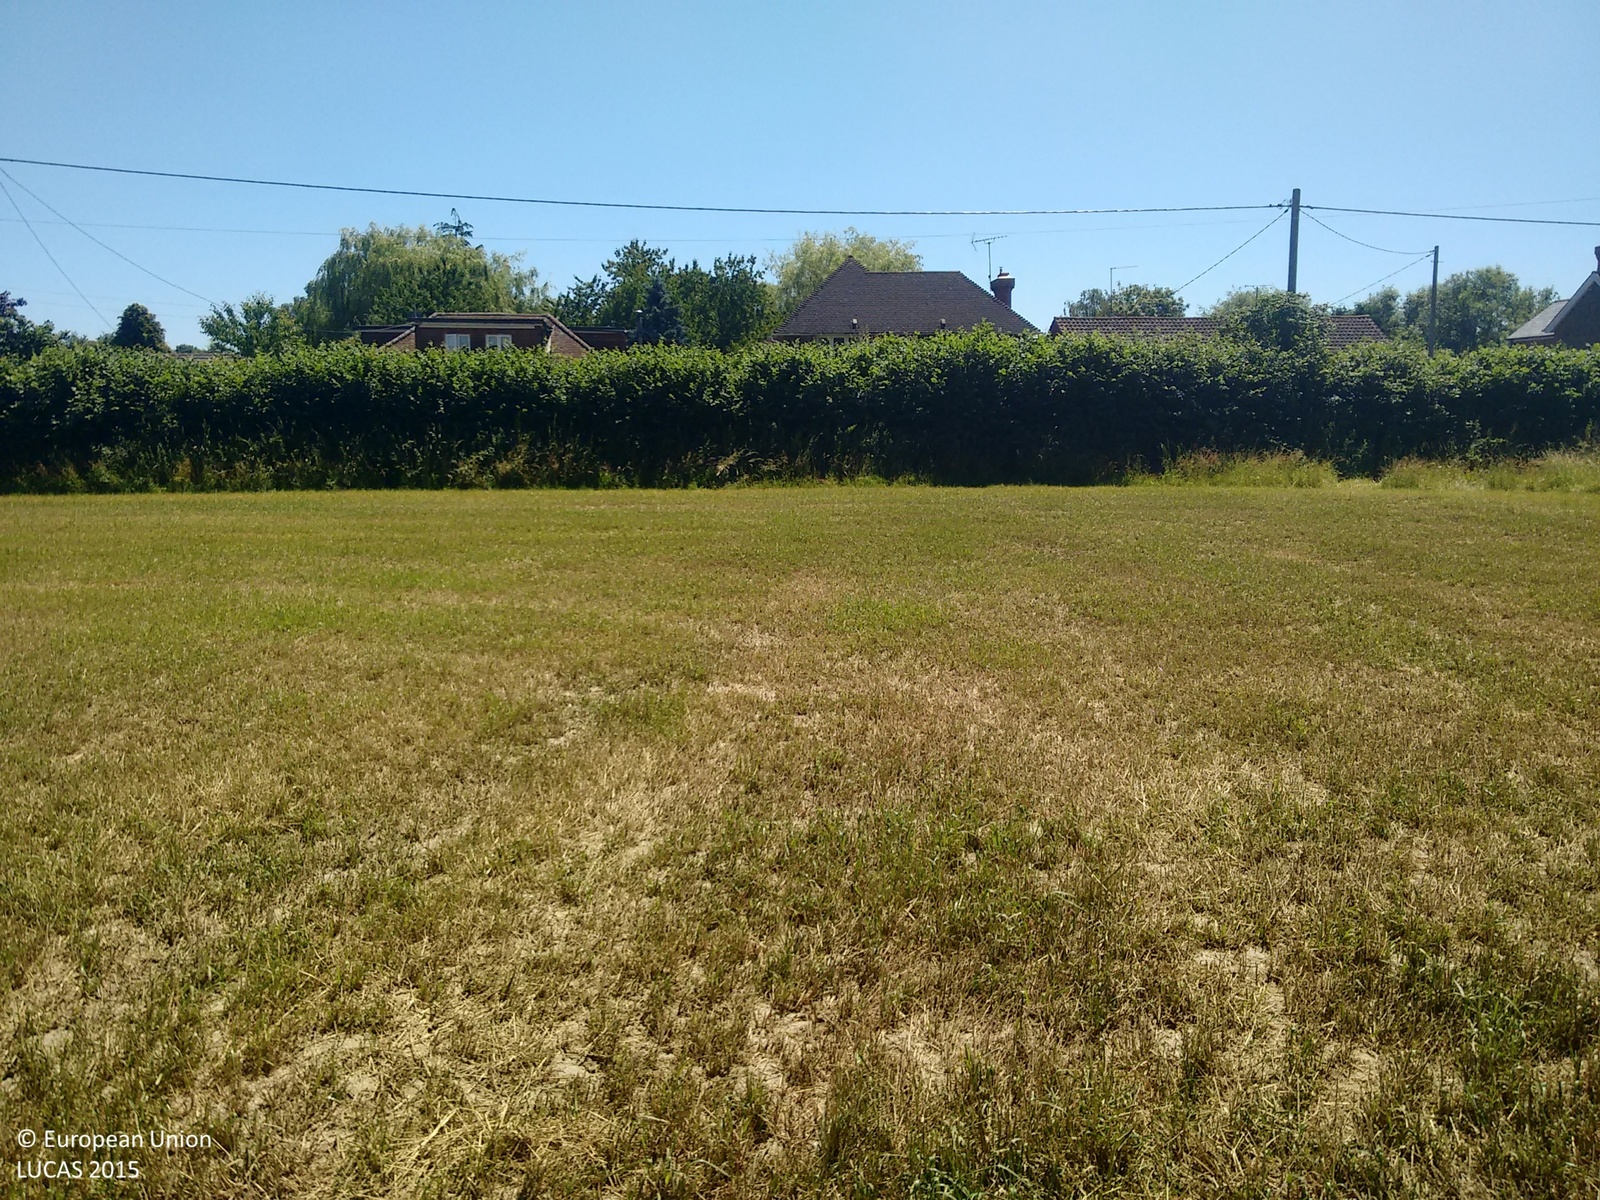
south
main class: Cropland
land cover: Temporary grasslands
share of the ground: > 75 %
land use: Agriculture (excluding fallow land and kitchen gardens)
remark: Harvested field
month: June
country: GB
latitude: 50.9316
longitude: -0.2949
